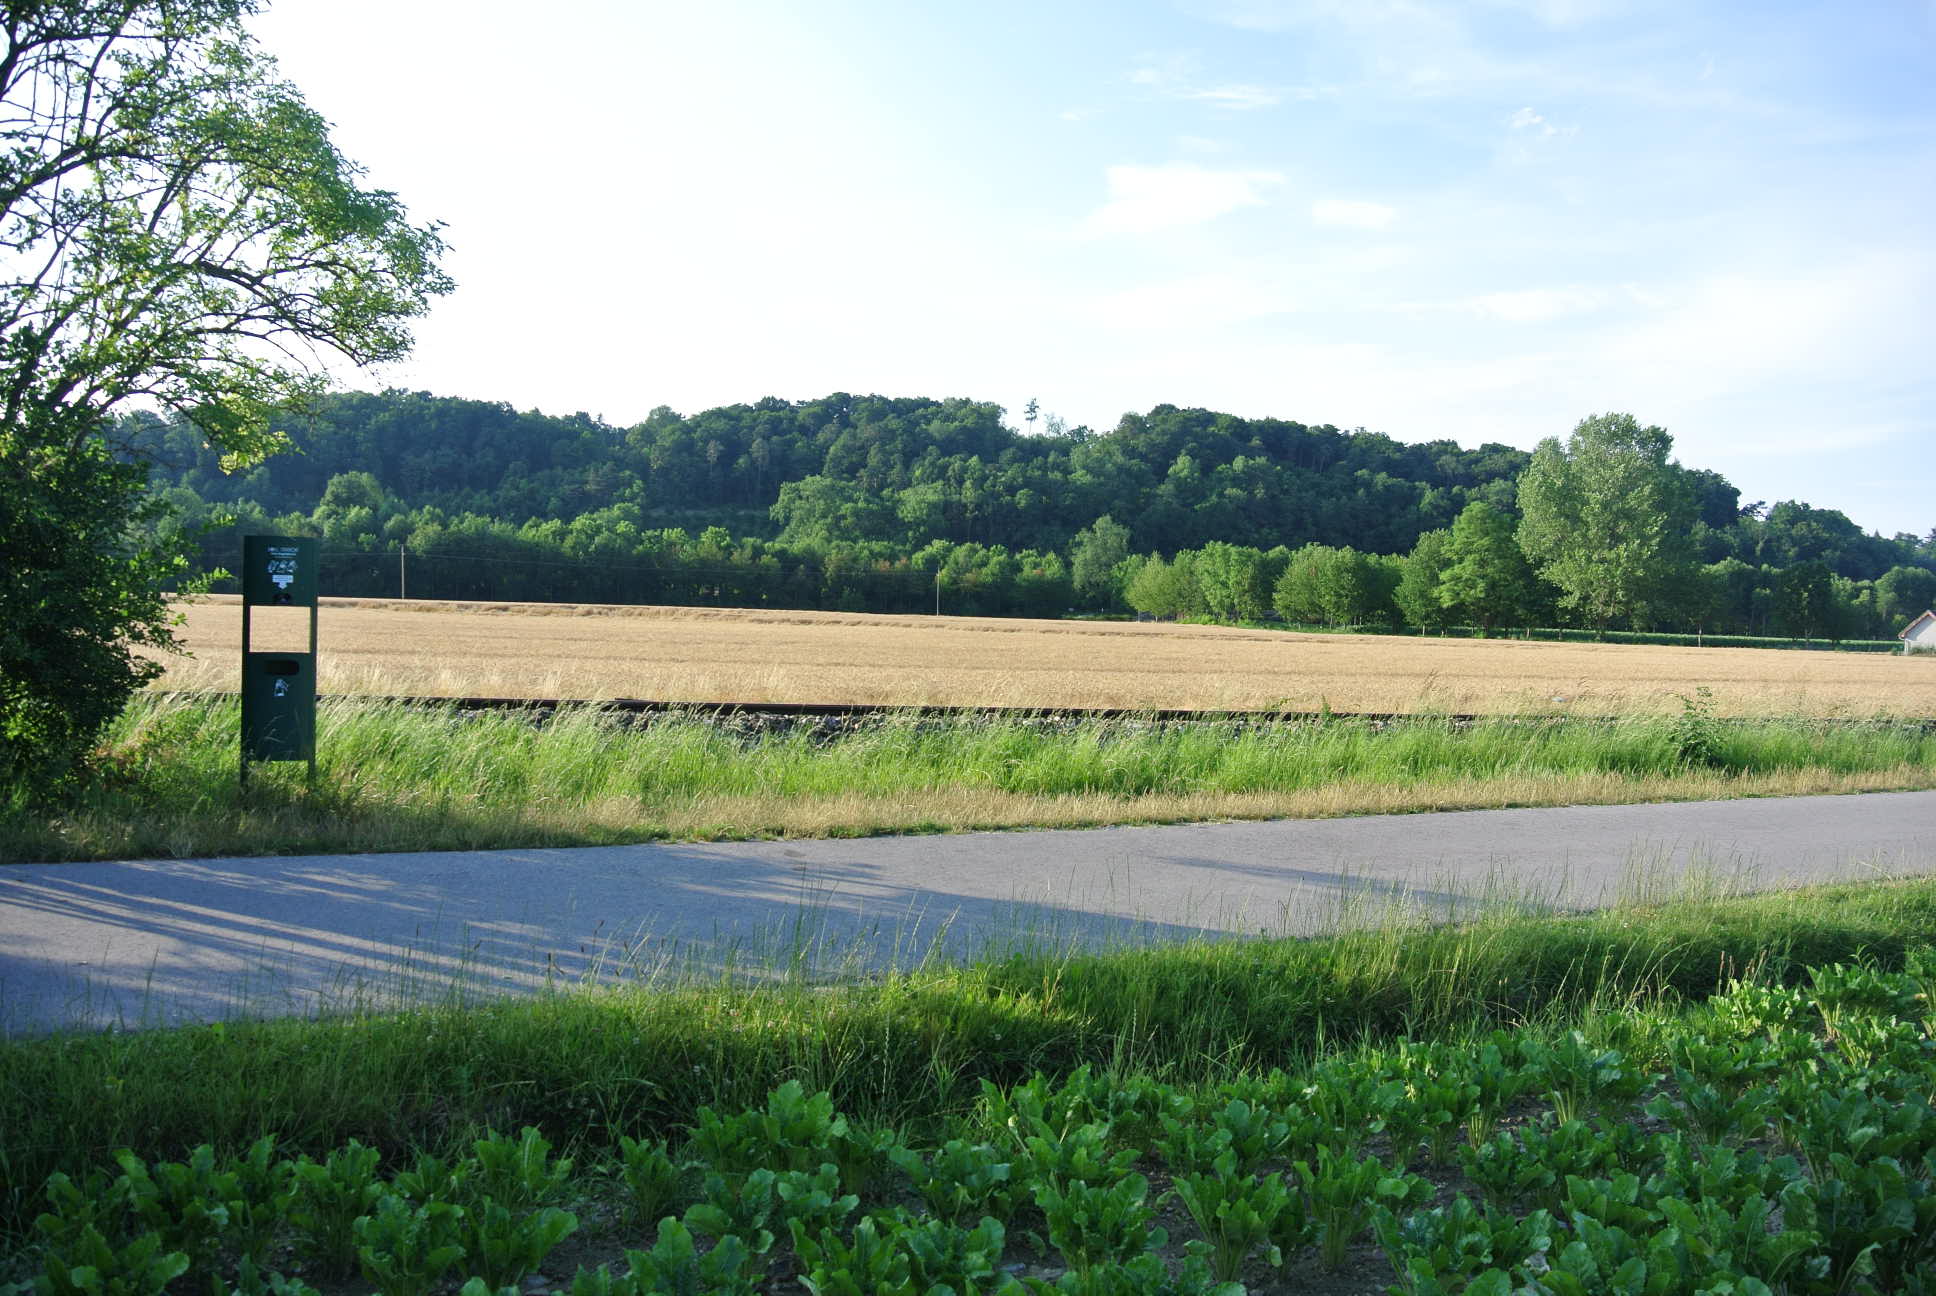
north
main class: Cropland
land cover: Sugar beet
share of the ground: > 75 %
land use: Agriculture (excluding fallow land and kitchen gardens)
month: July
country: AT
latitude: 47.7240
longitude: 16.2027
